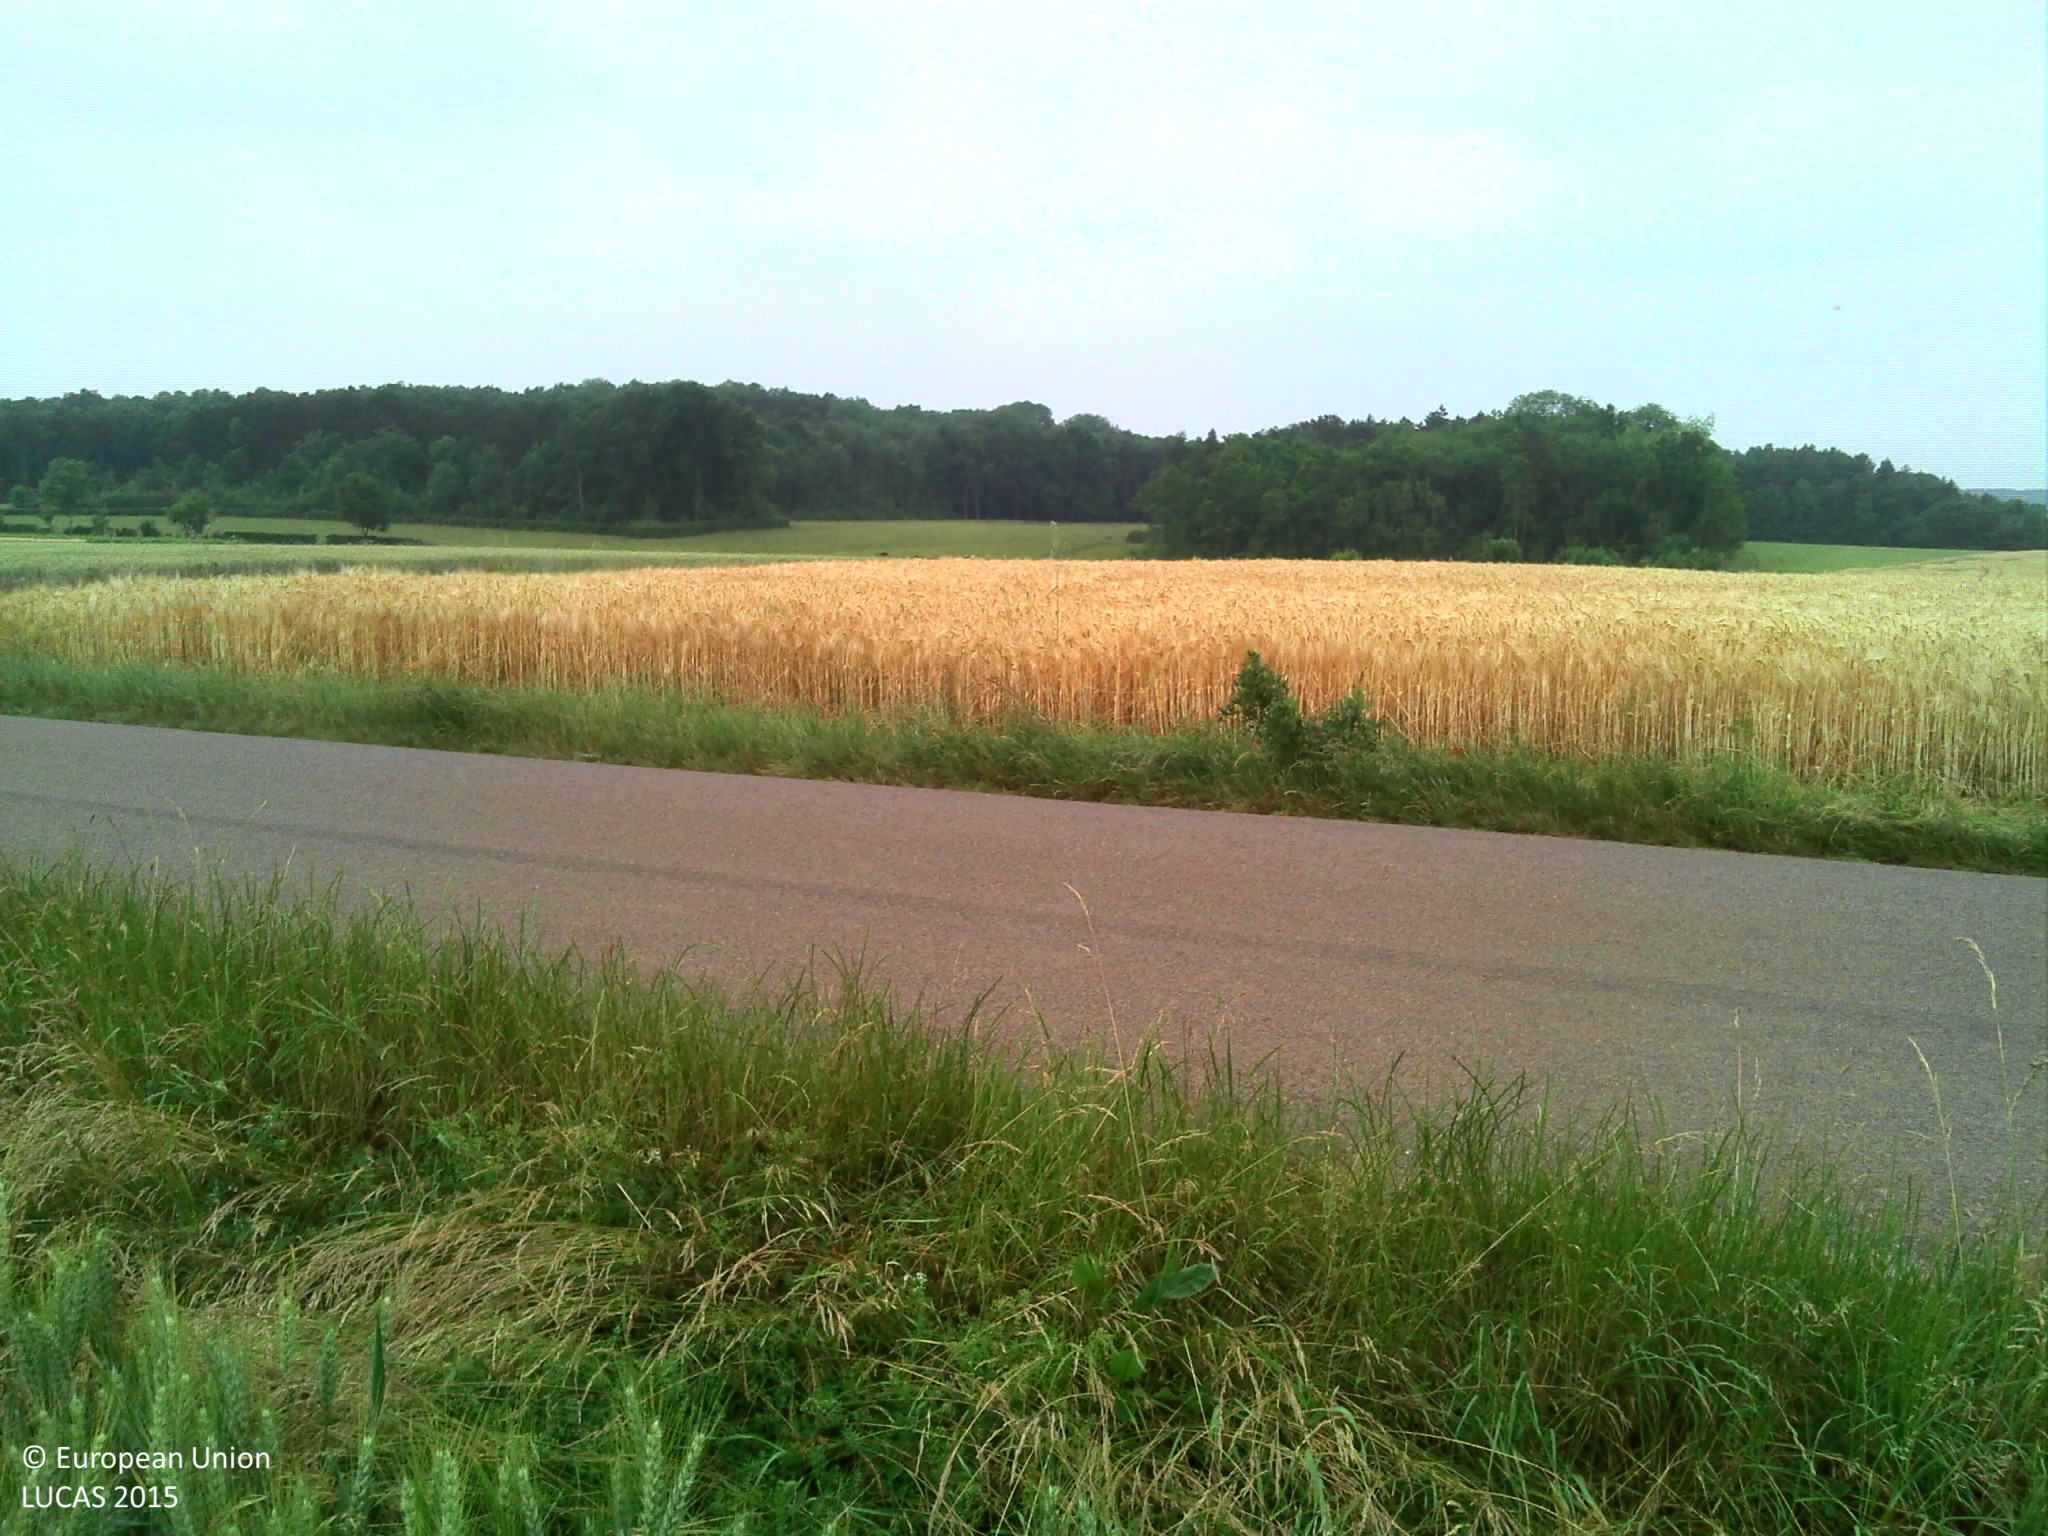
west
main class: Cropland
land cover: Common wheat
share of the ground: > 75 %
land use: Agriculture (excluding fallow land and kitchen gardens)
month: June
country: FR
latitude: 47.9108
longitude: 3.9089
